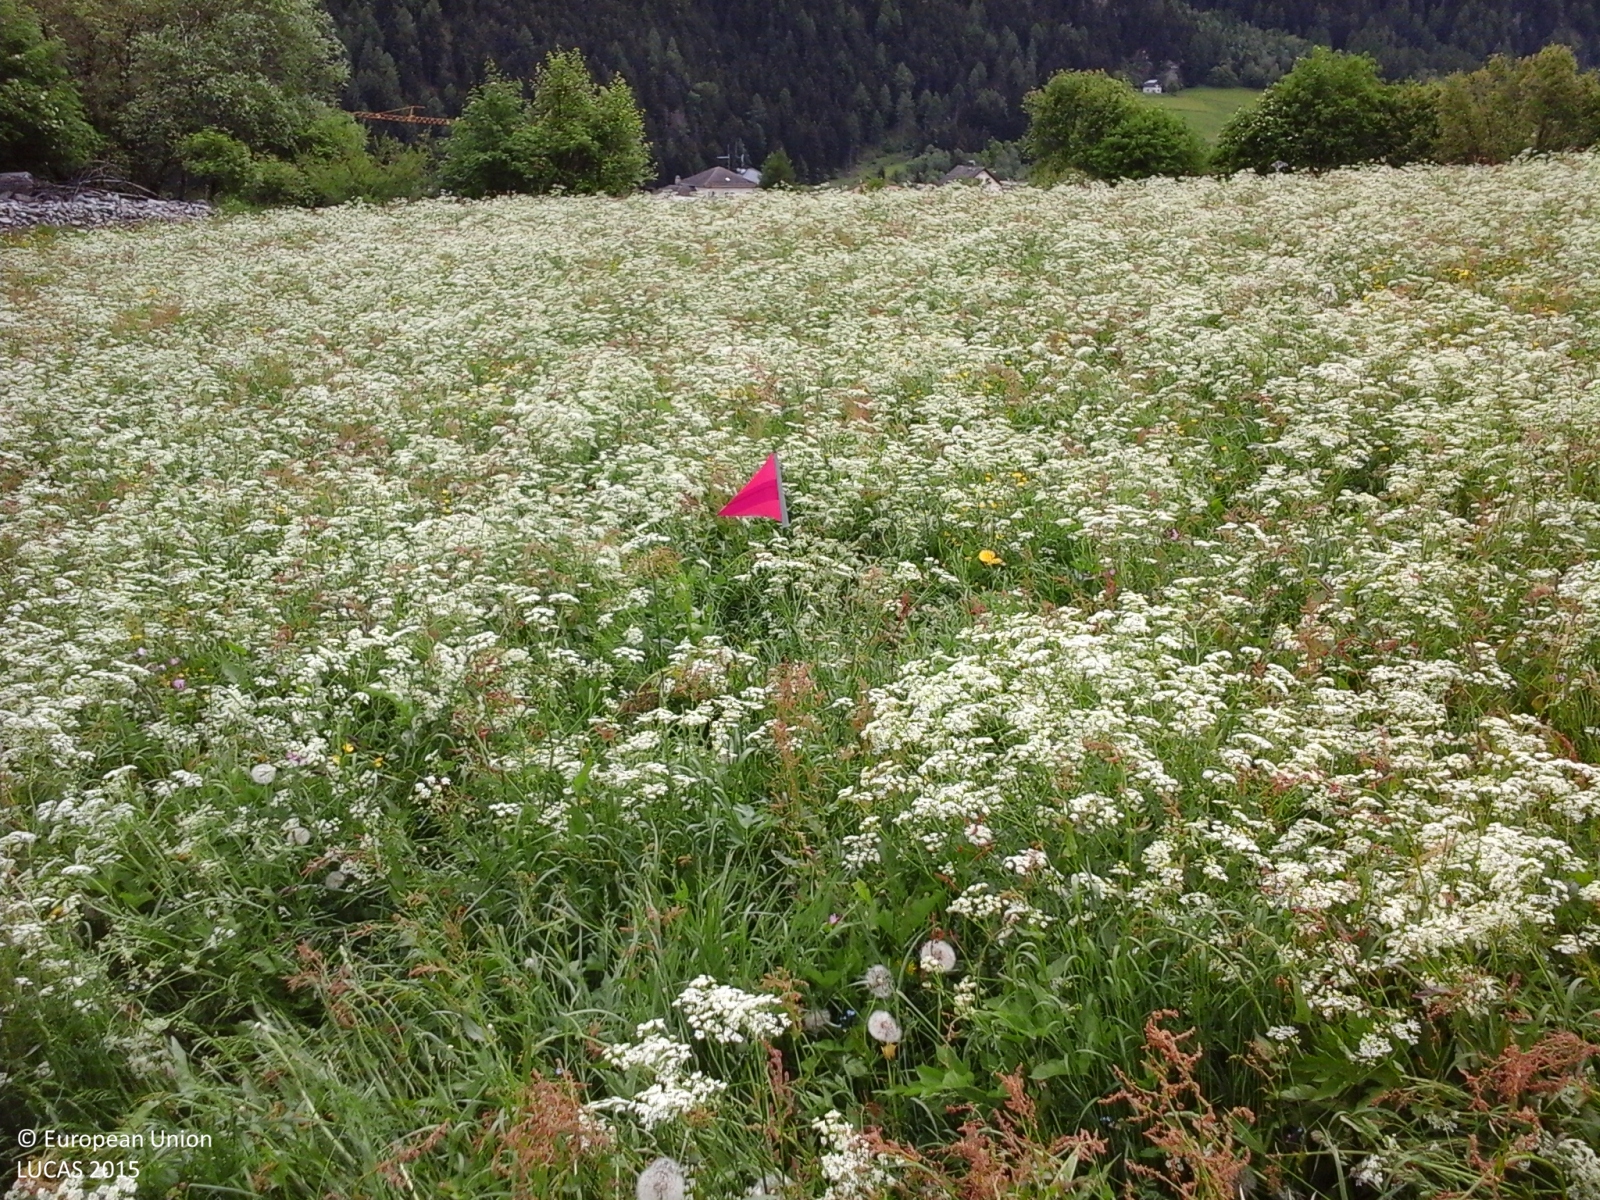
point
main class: Grassland
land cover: Grassland without tree/shrub cover
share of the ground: > 75 %
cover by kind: herbaceous plants 100 %
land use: Agriculture (excluding fallow land and kitchen gardens)
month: May
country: IT
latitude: 46.6384
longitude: 10.4567
